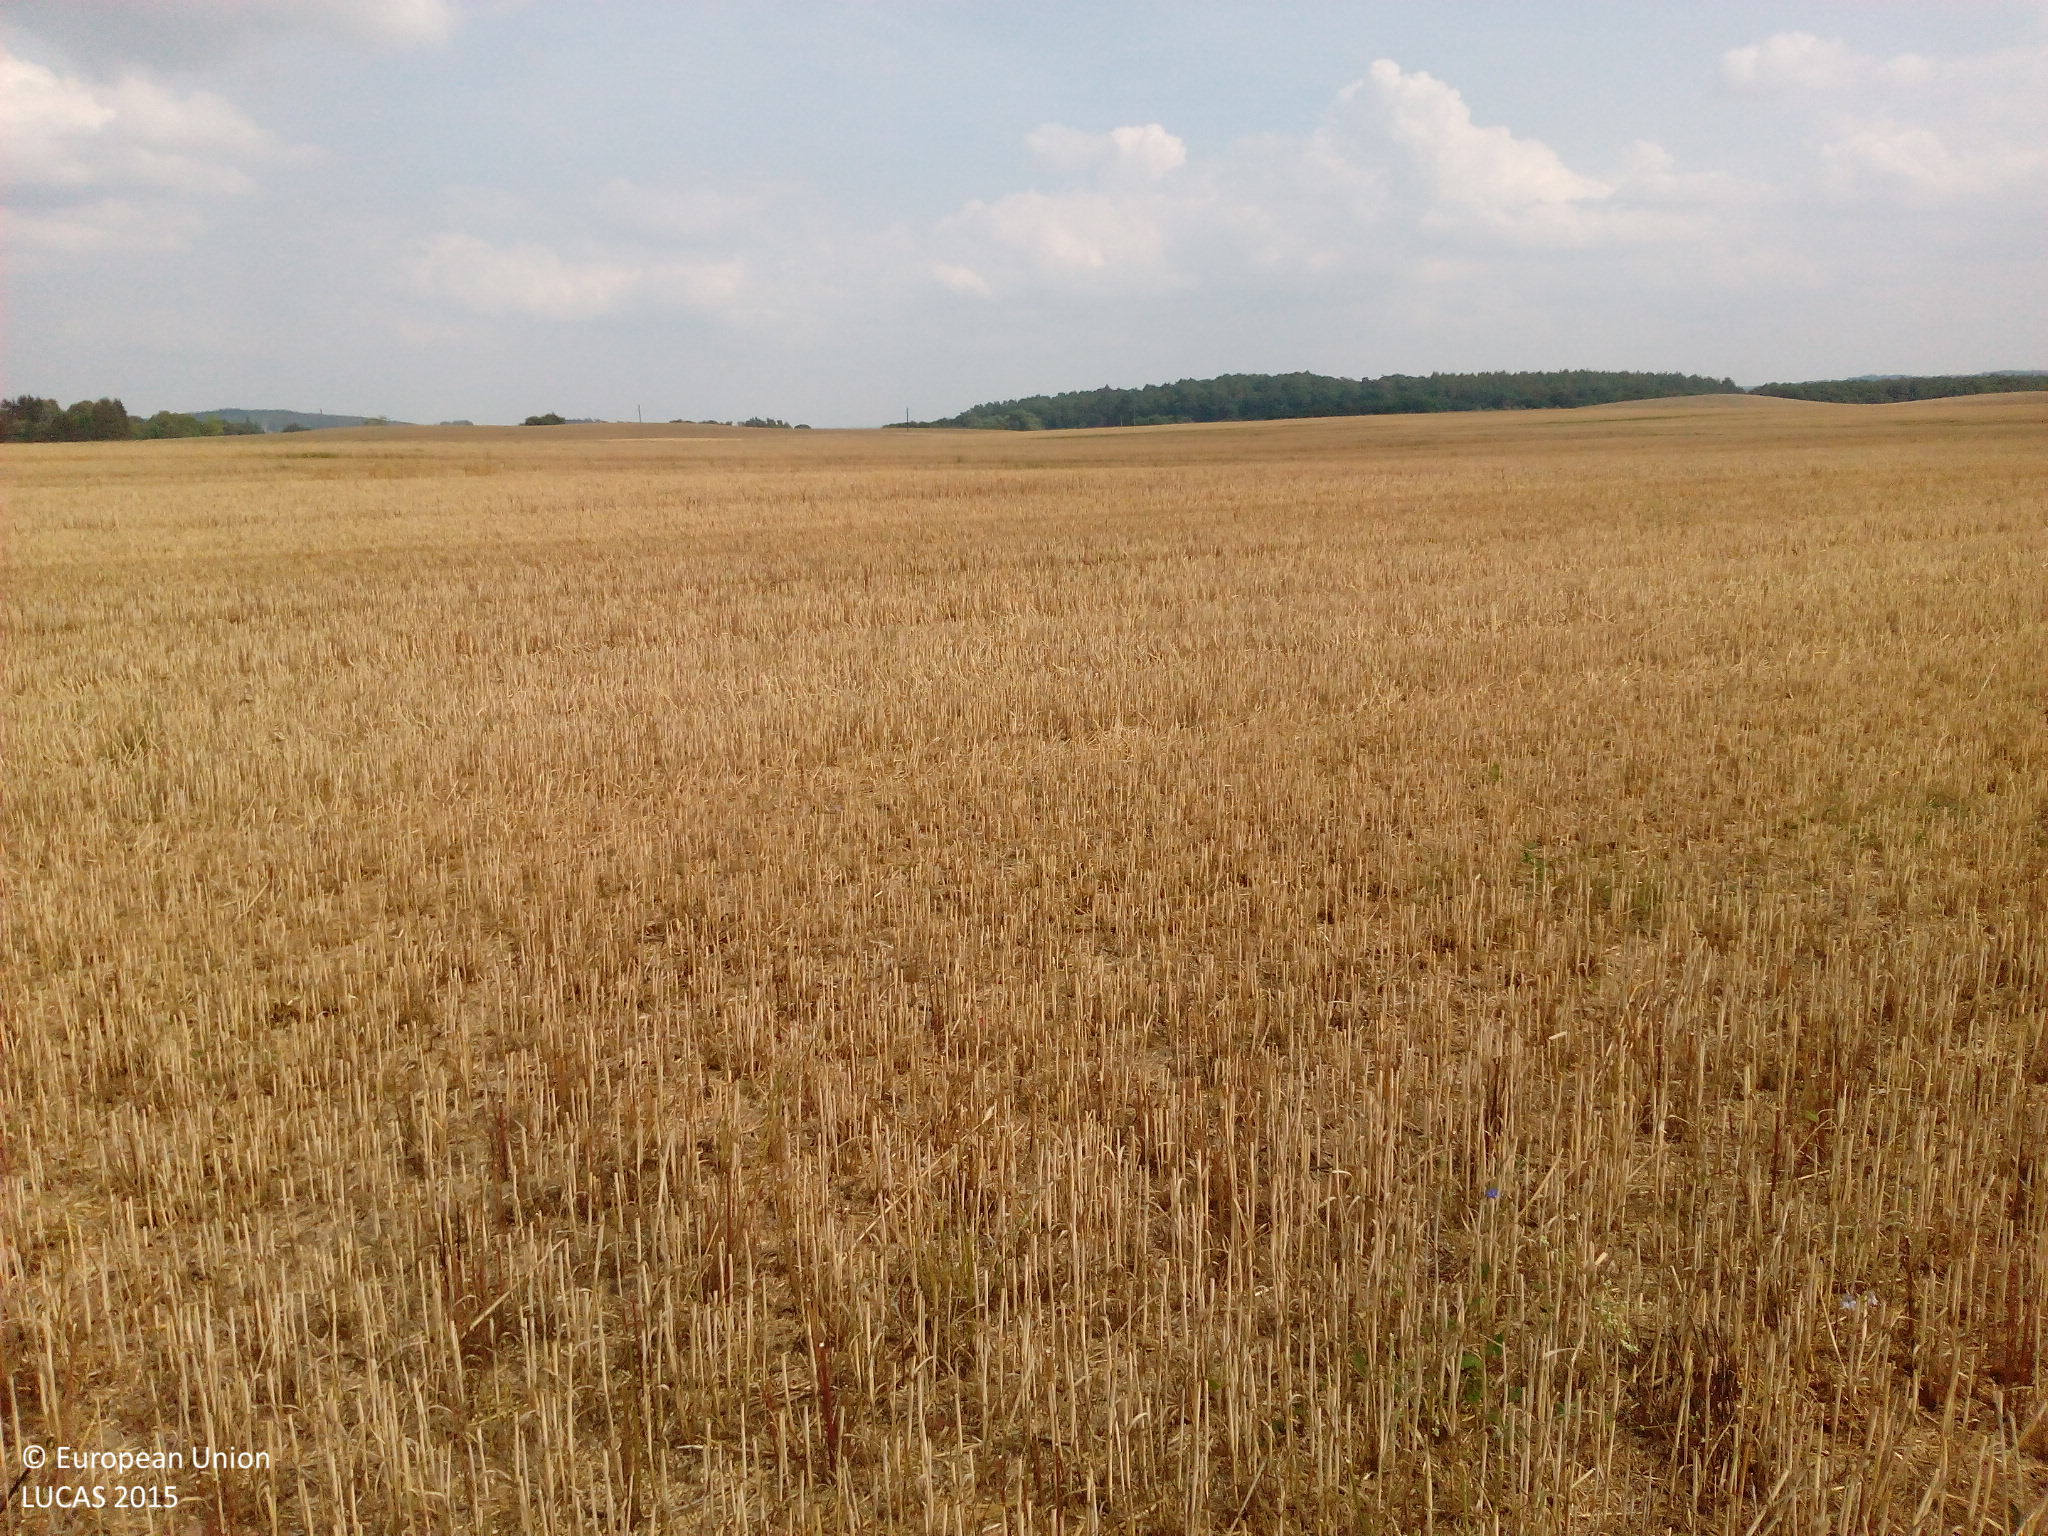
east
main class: Cropland
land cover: Common wheat
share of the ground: < 10 %
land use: Agriculture (excluding fallow land and kitchen gardens)
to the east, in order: Common wheat
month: August
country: DE
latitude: 53.7159
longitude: 12.5903
